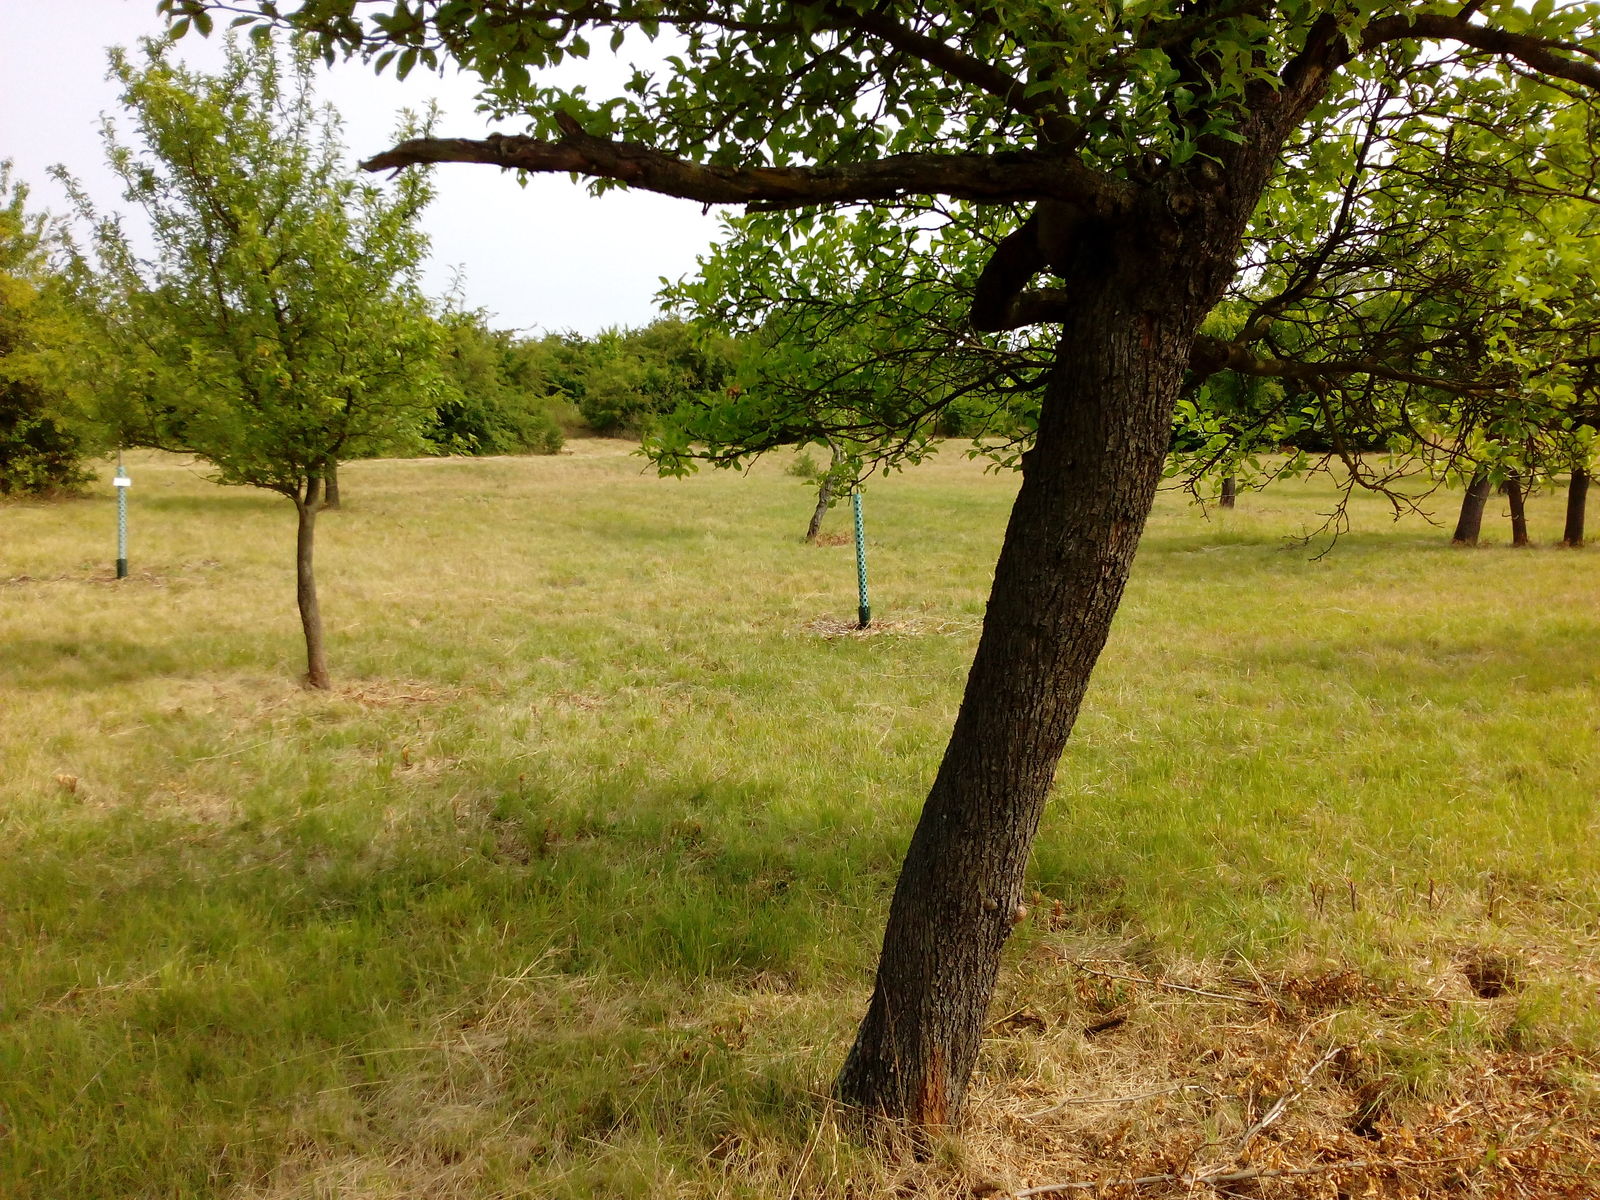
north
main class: Cropland
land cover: Apple fruit
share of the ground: 25 - 50 %
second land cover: Grassland without tree/shrub cover
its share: > 75 %
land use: Agriculture (excluding fallow land and kitchen gardens)
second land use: Amenities, museums, leisure
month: June
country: DE
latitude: 51.3656
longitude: 11.1057
